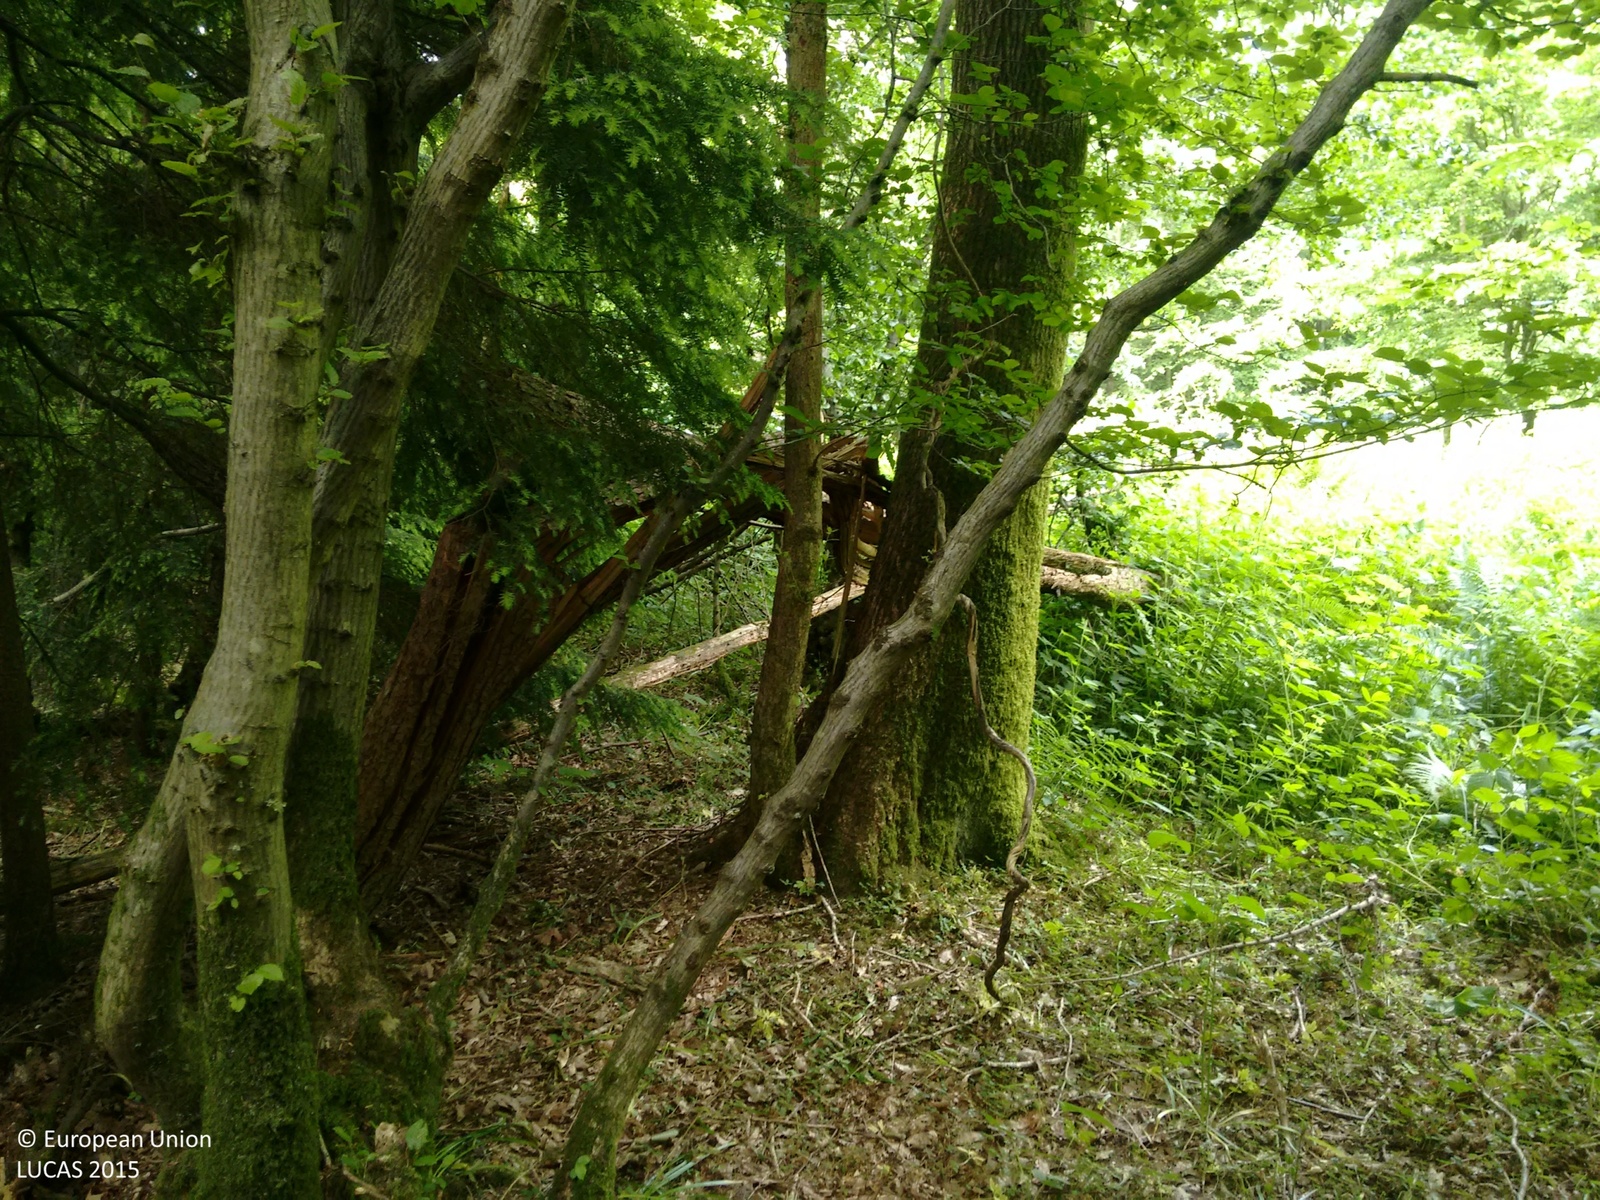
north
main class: Woodland
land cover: Other mixed woodland
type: exotic forest
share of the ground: > 75 %
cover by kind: coniferous forest trees 70 %, broadleaved forest trees 30 %
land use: Forestry
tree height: > 5 m
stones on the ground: < 10 %
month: June
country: GB
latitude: 50.9439
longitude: 0.4789
